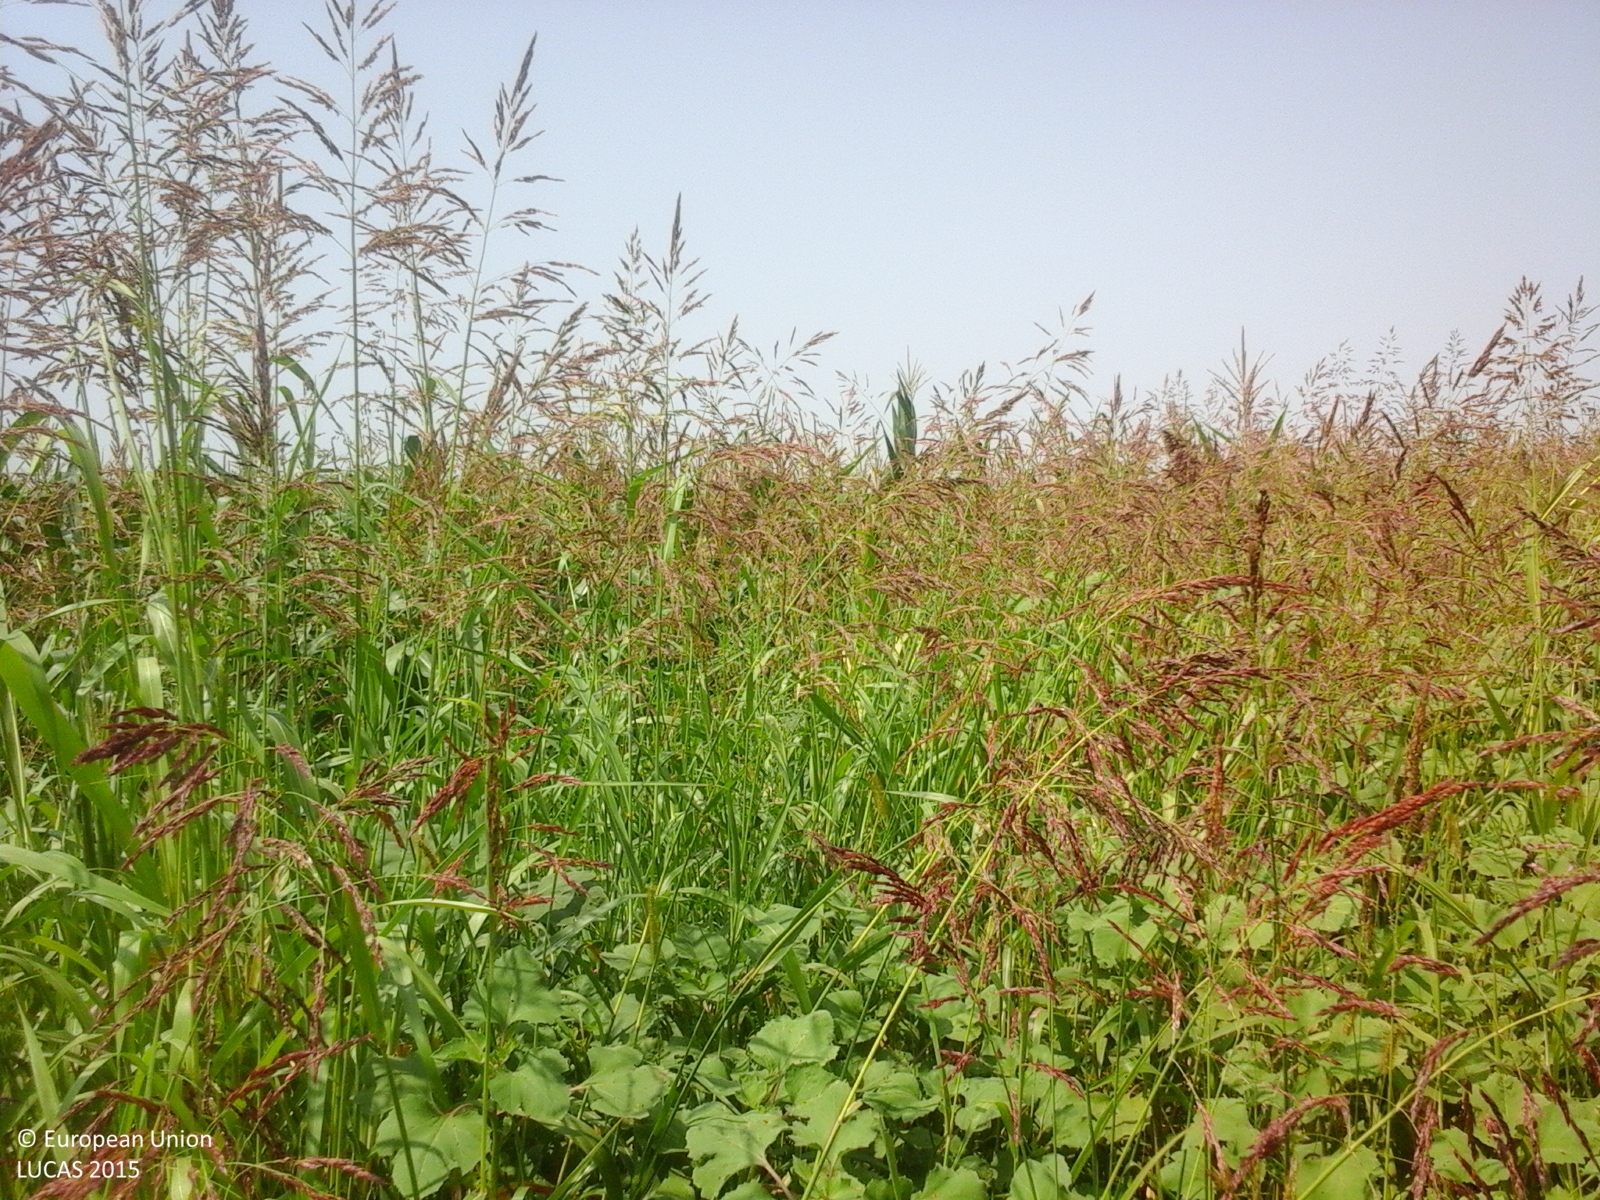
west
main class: Grassland
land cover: Spontaneously vegetated surfaces
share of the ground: > 75 %
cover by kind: herbaceous plants 100 %
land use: Fallow land
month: July
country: RO
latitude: 44.6076
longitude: 26.5616
